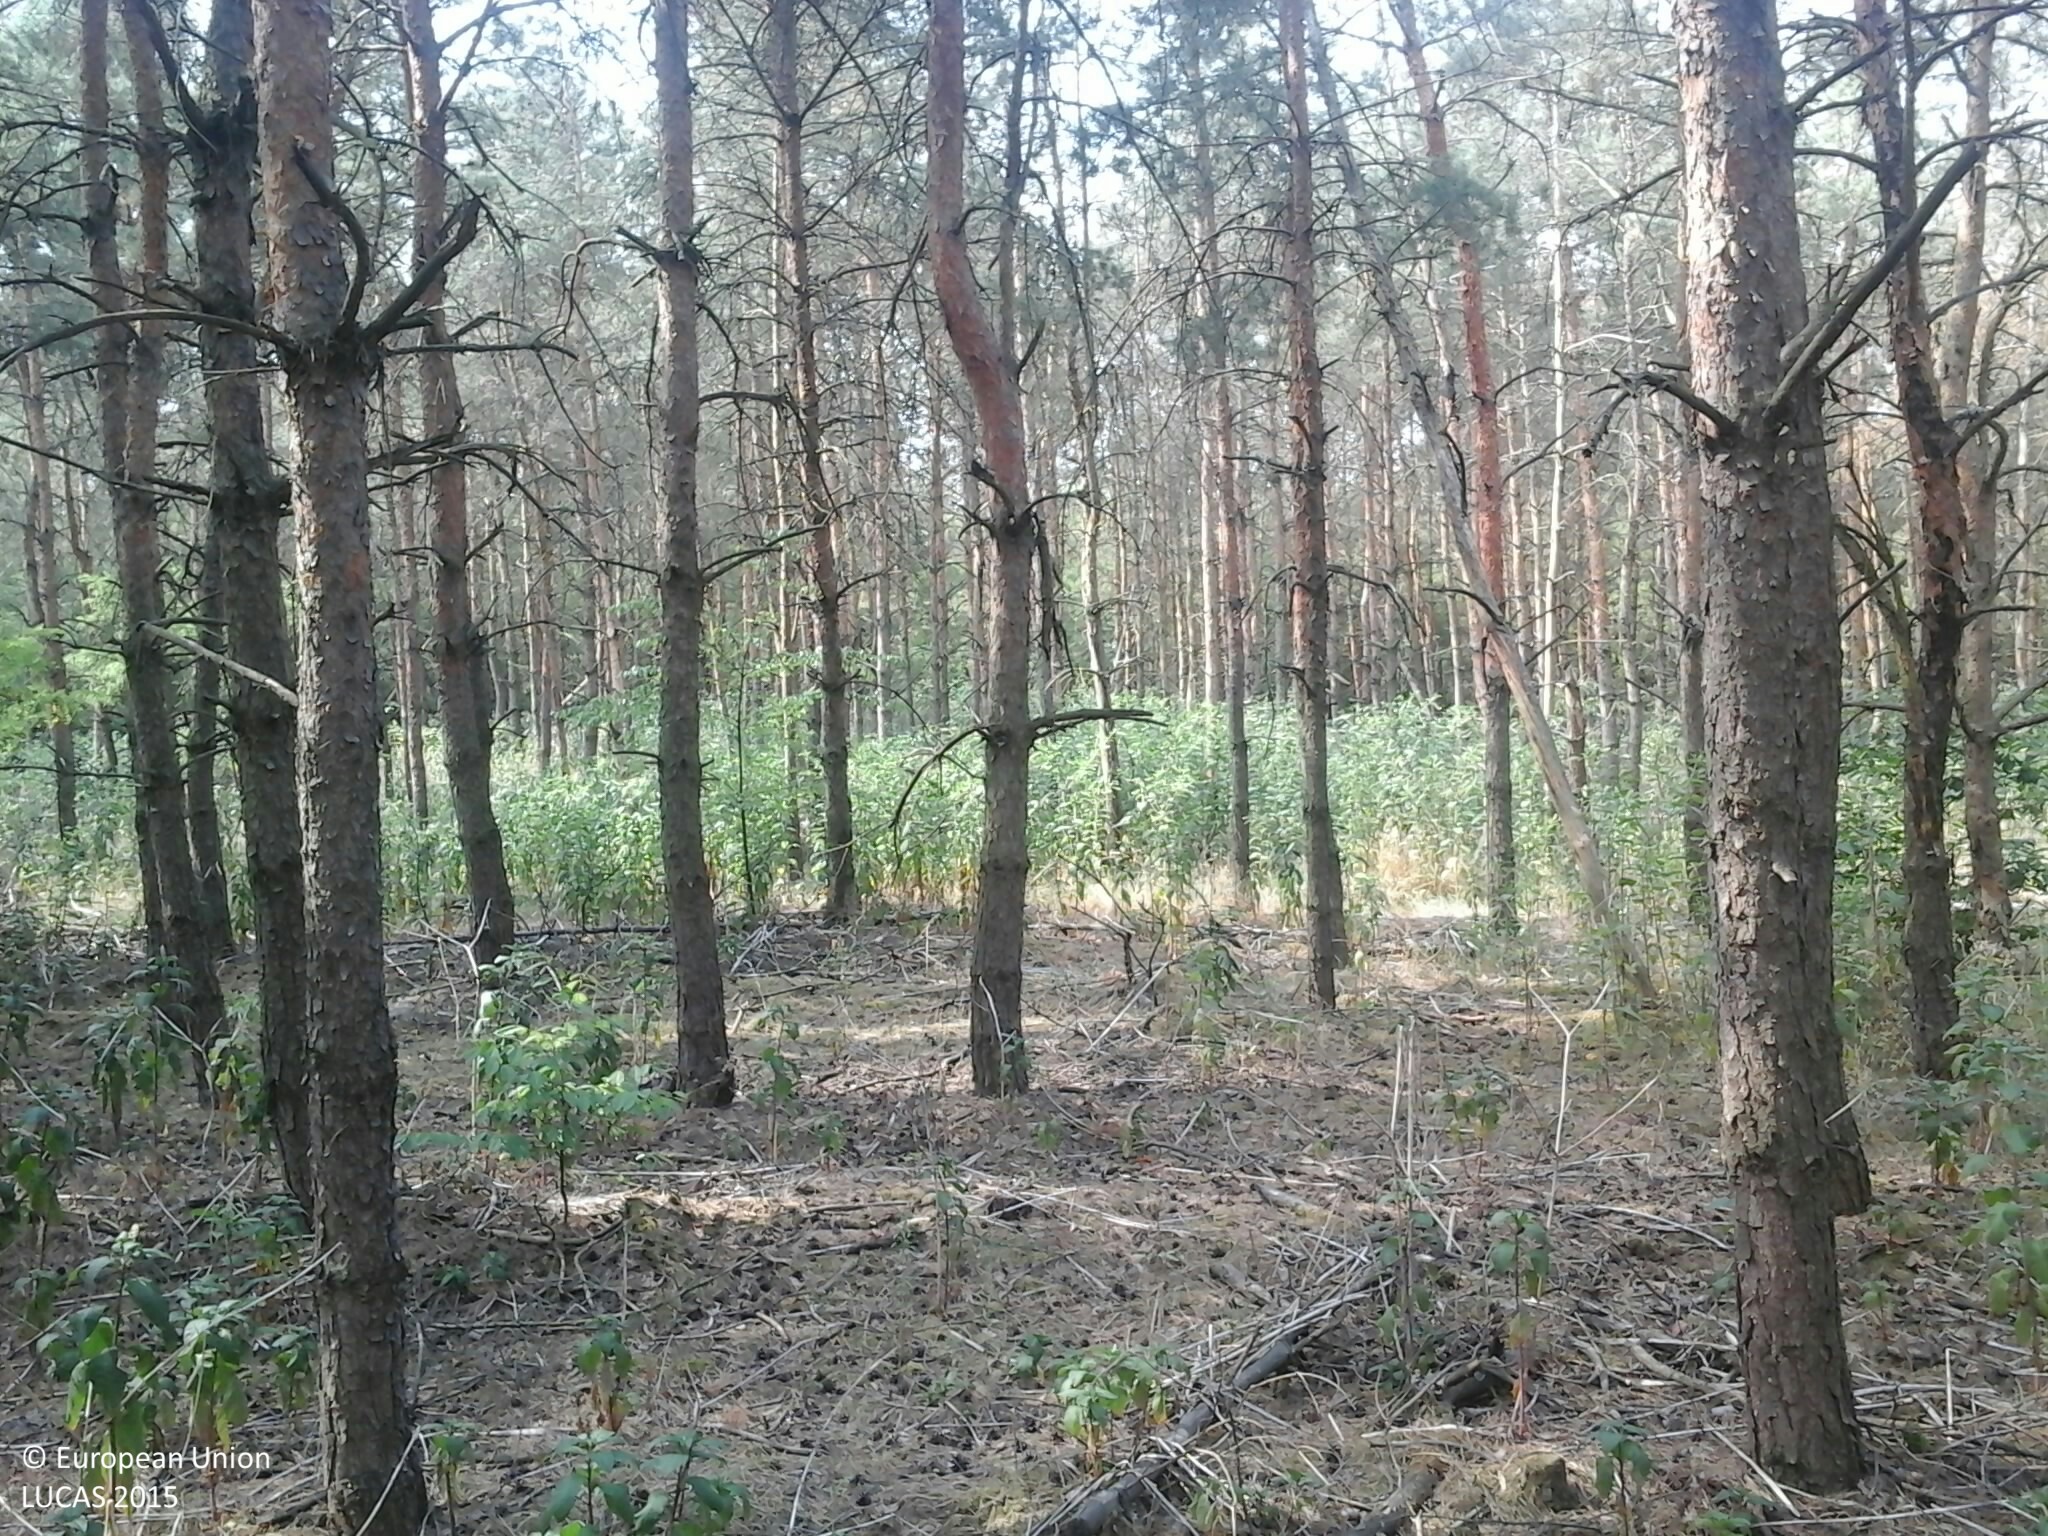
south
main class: Woodland
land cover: Pine dominated mixed woodland
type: hemiboreal forest and nemoral coniferous forest and mixed broadleaved-coniferous forest
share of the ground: > 75 %
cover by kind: coniferous forest trees 70 %, broadleaved forest trees 25 %, lichens and mosses 5 %
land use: Forestry
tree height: > 5 m
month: July
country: HU
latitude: 47.7221
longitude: 22.2255
